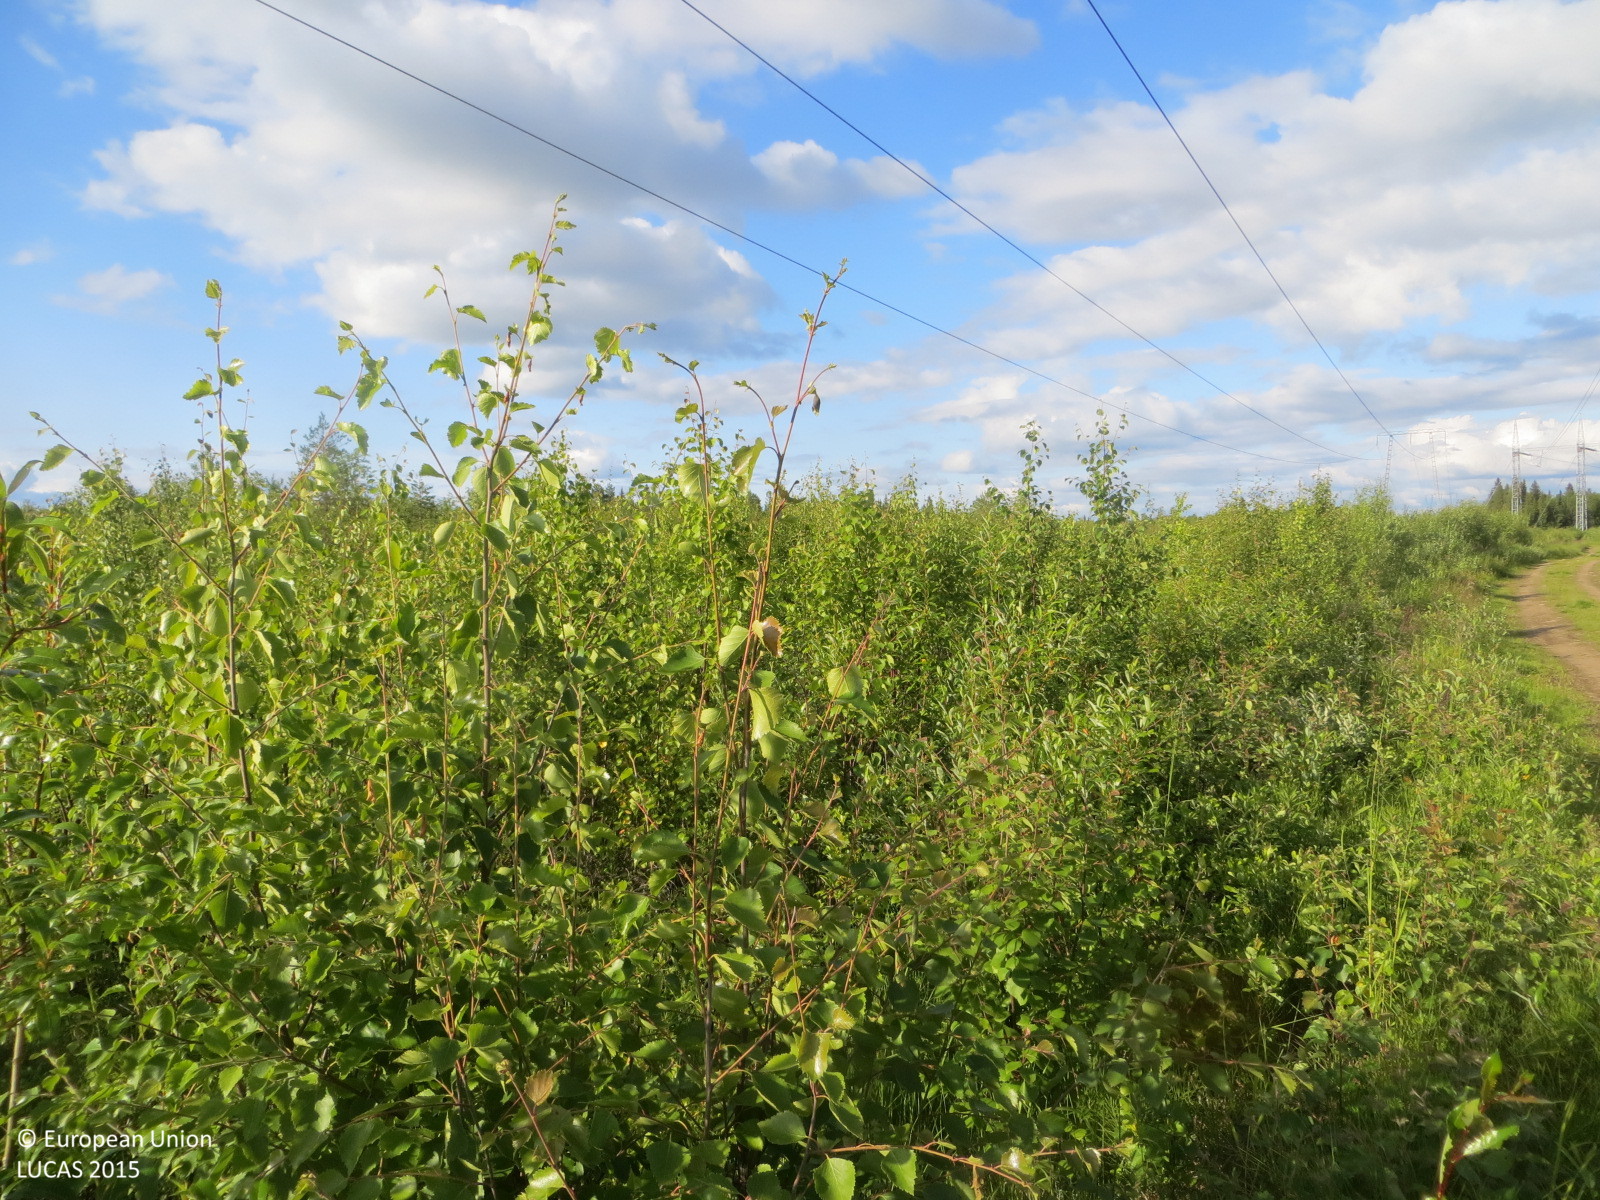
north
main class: Shrubland
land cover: Shrubland with sparse tree cover
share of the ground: > 75 %
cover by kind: shrubs 55 %, lichens and mosses 40 %, broadleaved forest trees 5 %
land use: Electricity, gas and thermal power distribution
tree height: < 5 m
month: July
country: FI
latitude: 65.9610
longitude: 24.0579
